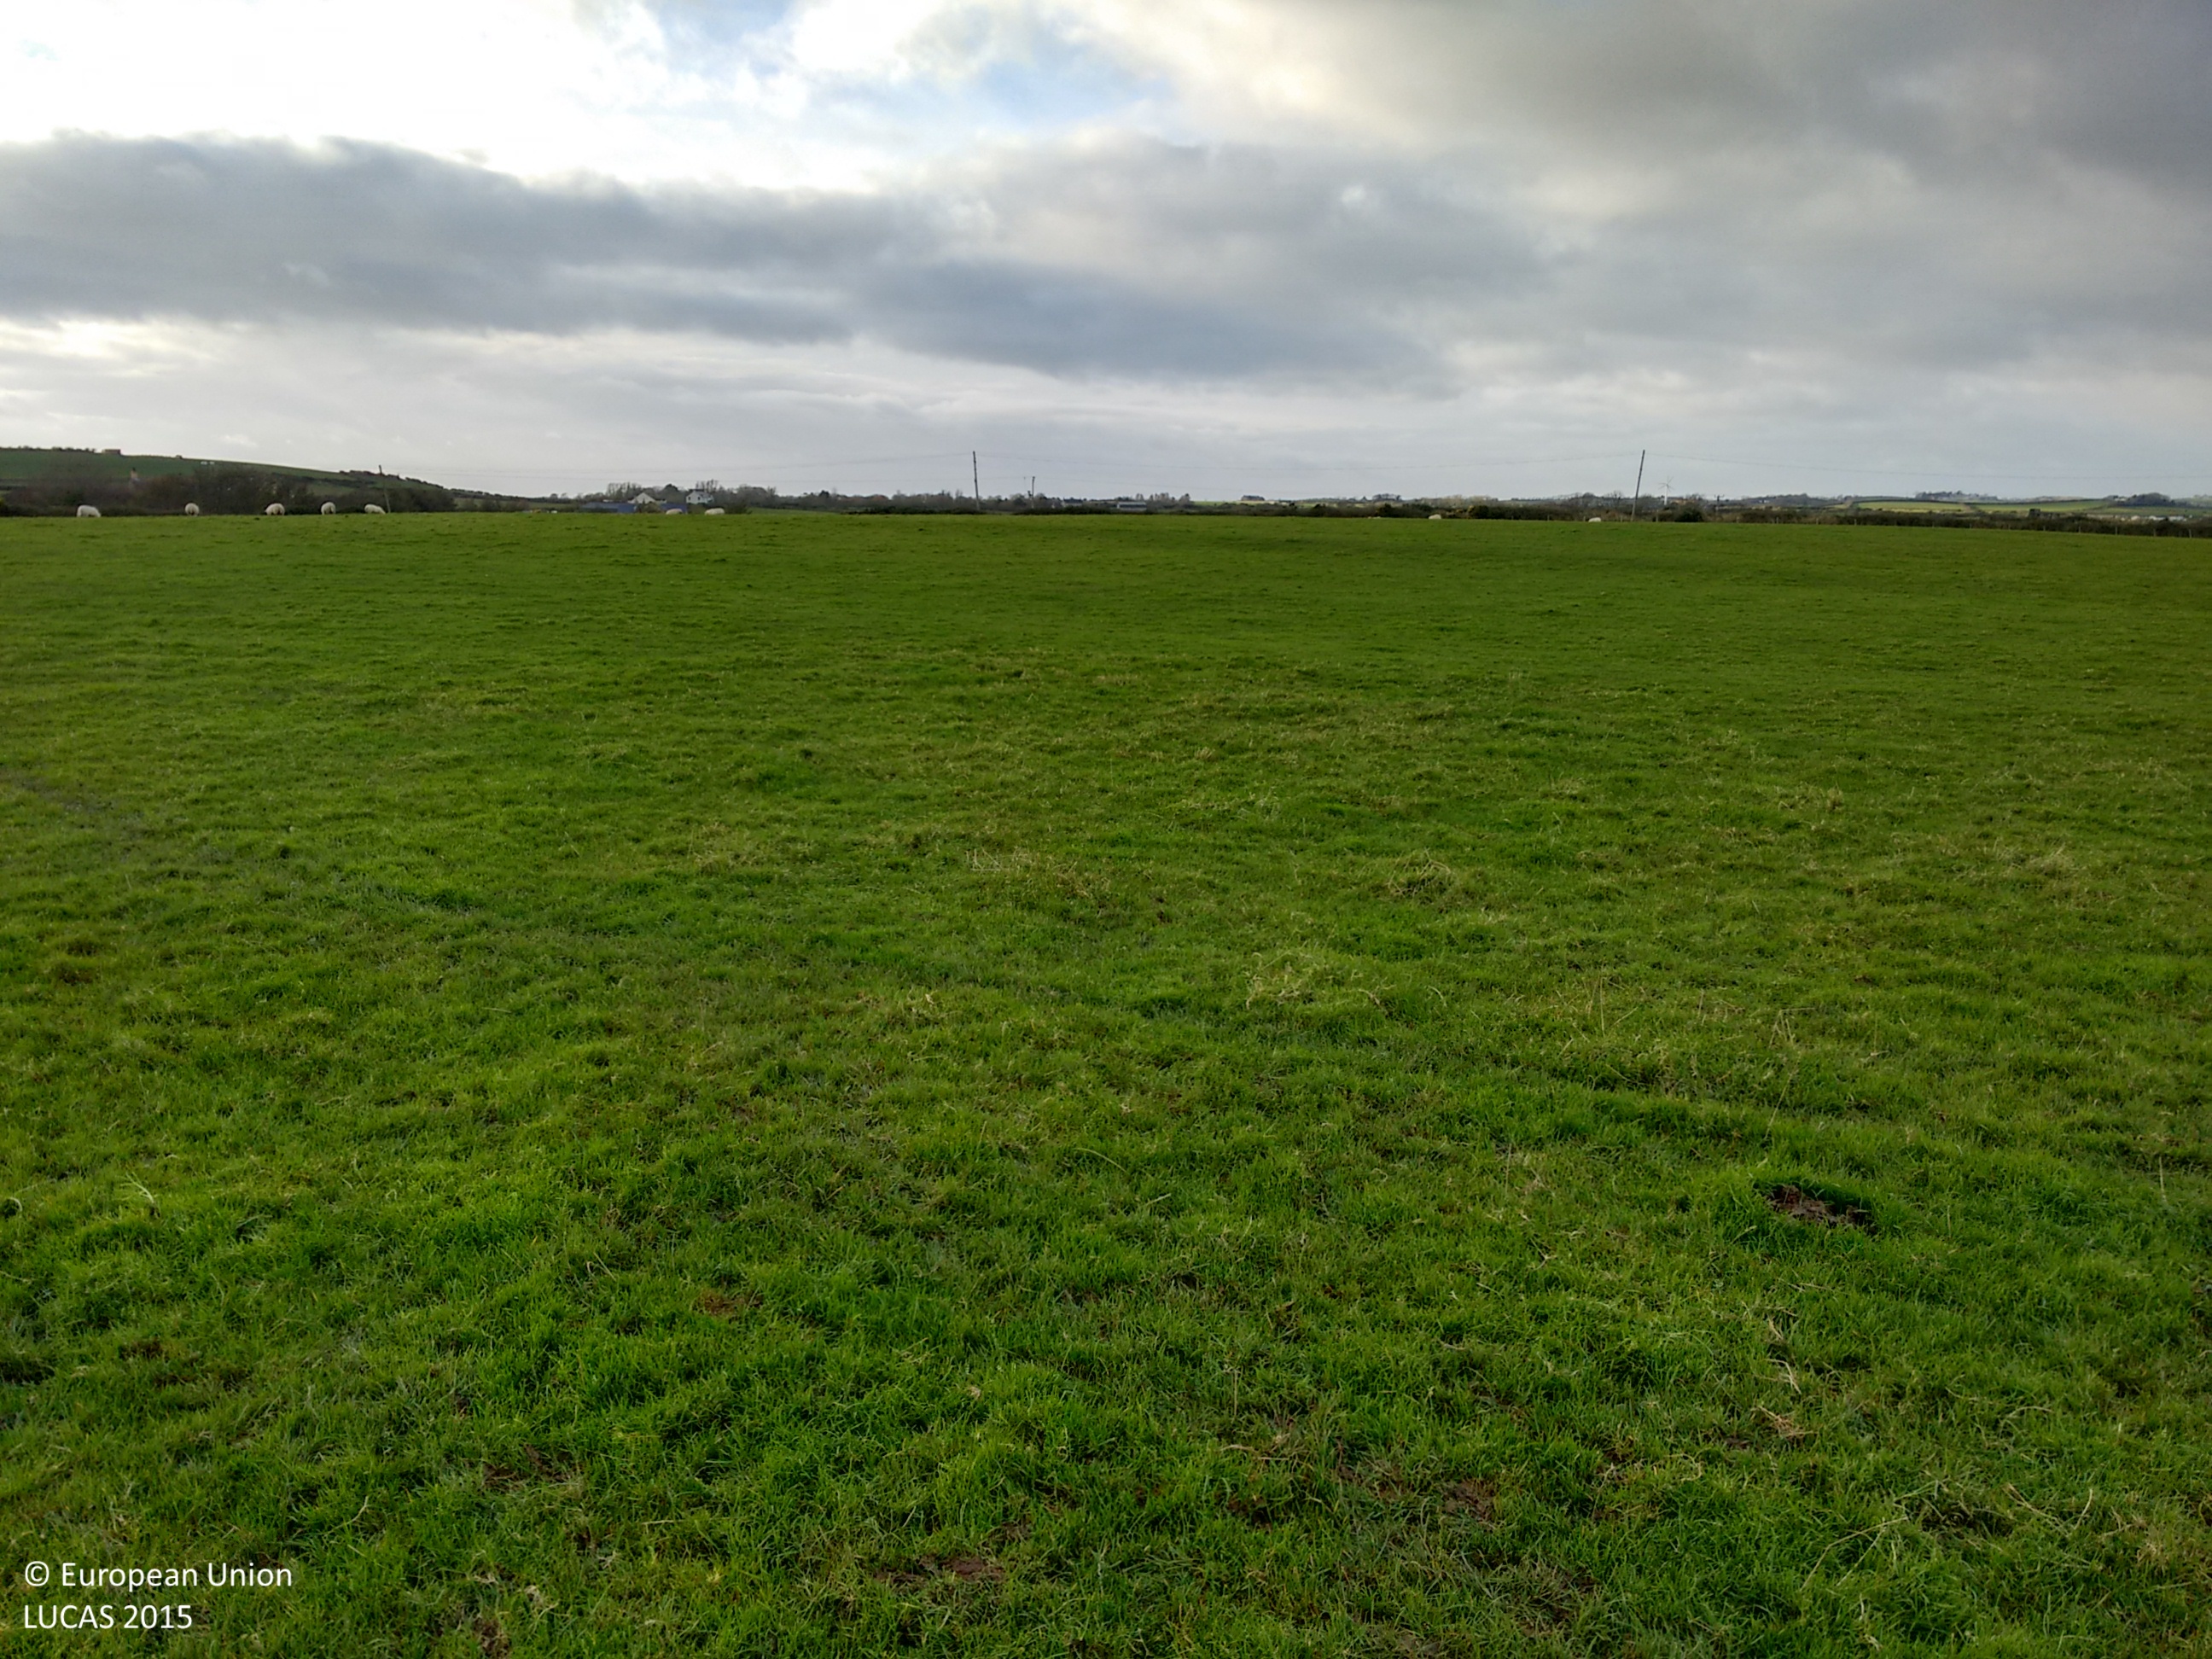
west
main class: Grassland
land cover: Grassland without tree/shrub cover
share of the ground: > 75 %
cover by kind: herbaceous plants 100 %
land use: Agriculture (excluding fallow land and kitchen gardens)
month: November
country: GB
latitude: 54.4908
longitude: -5.4561
